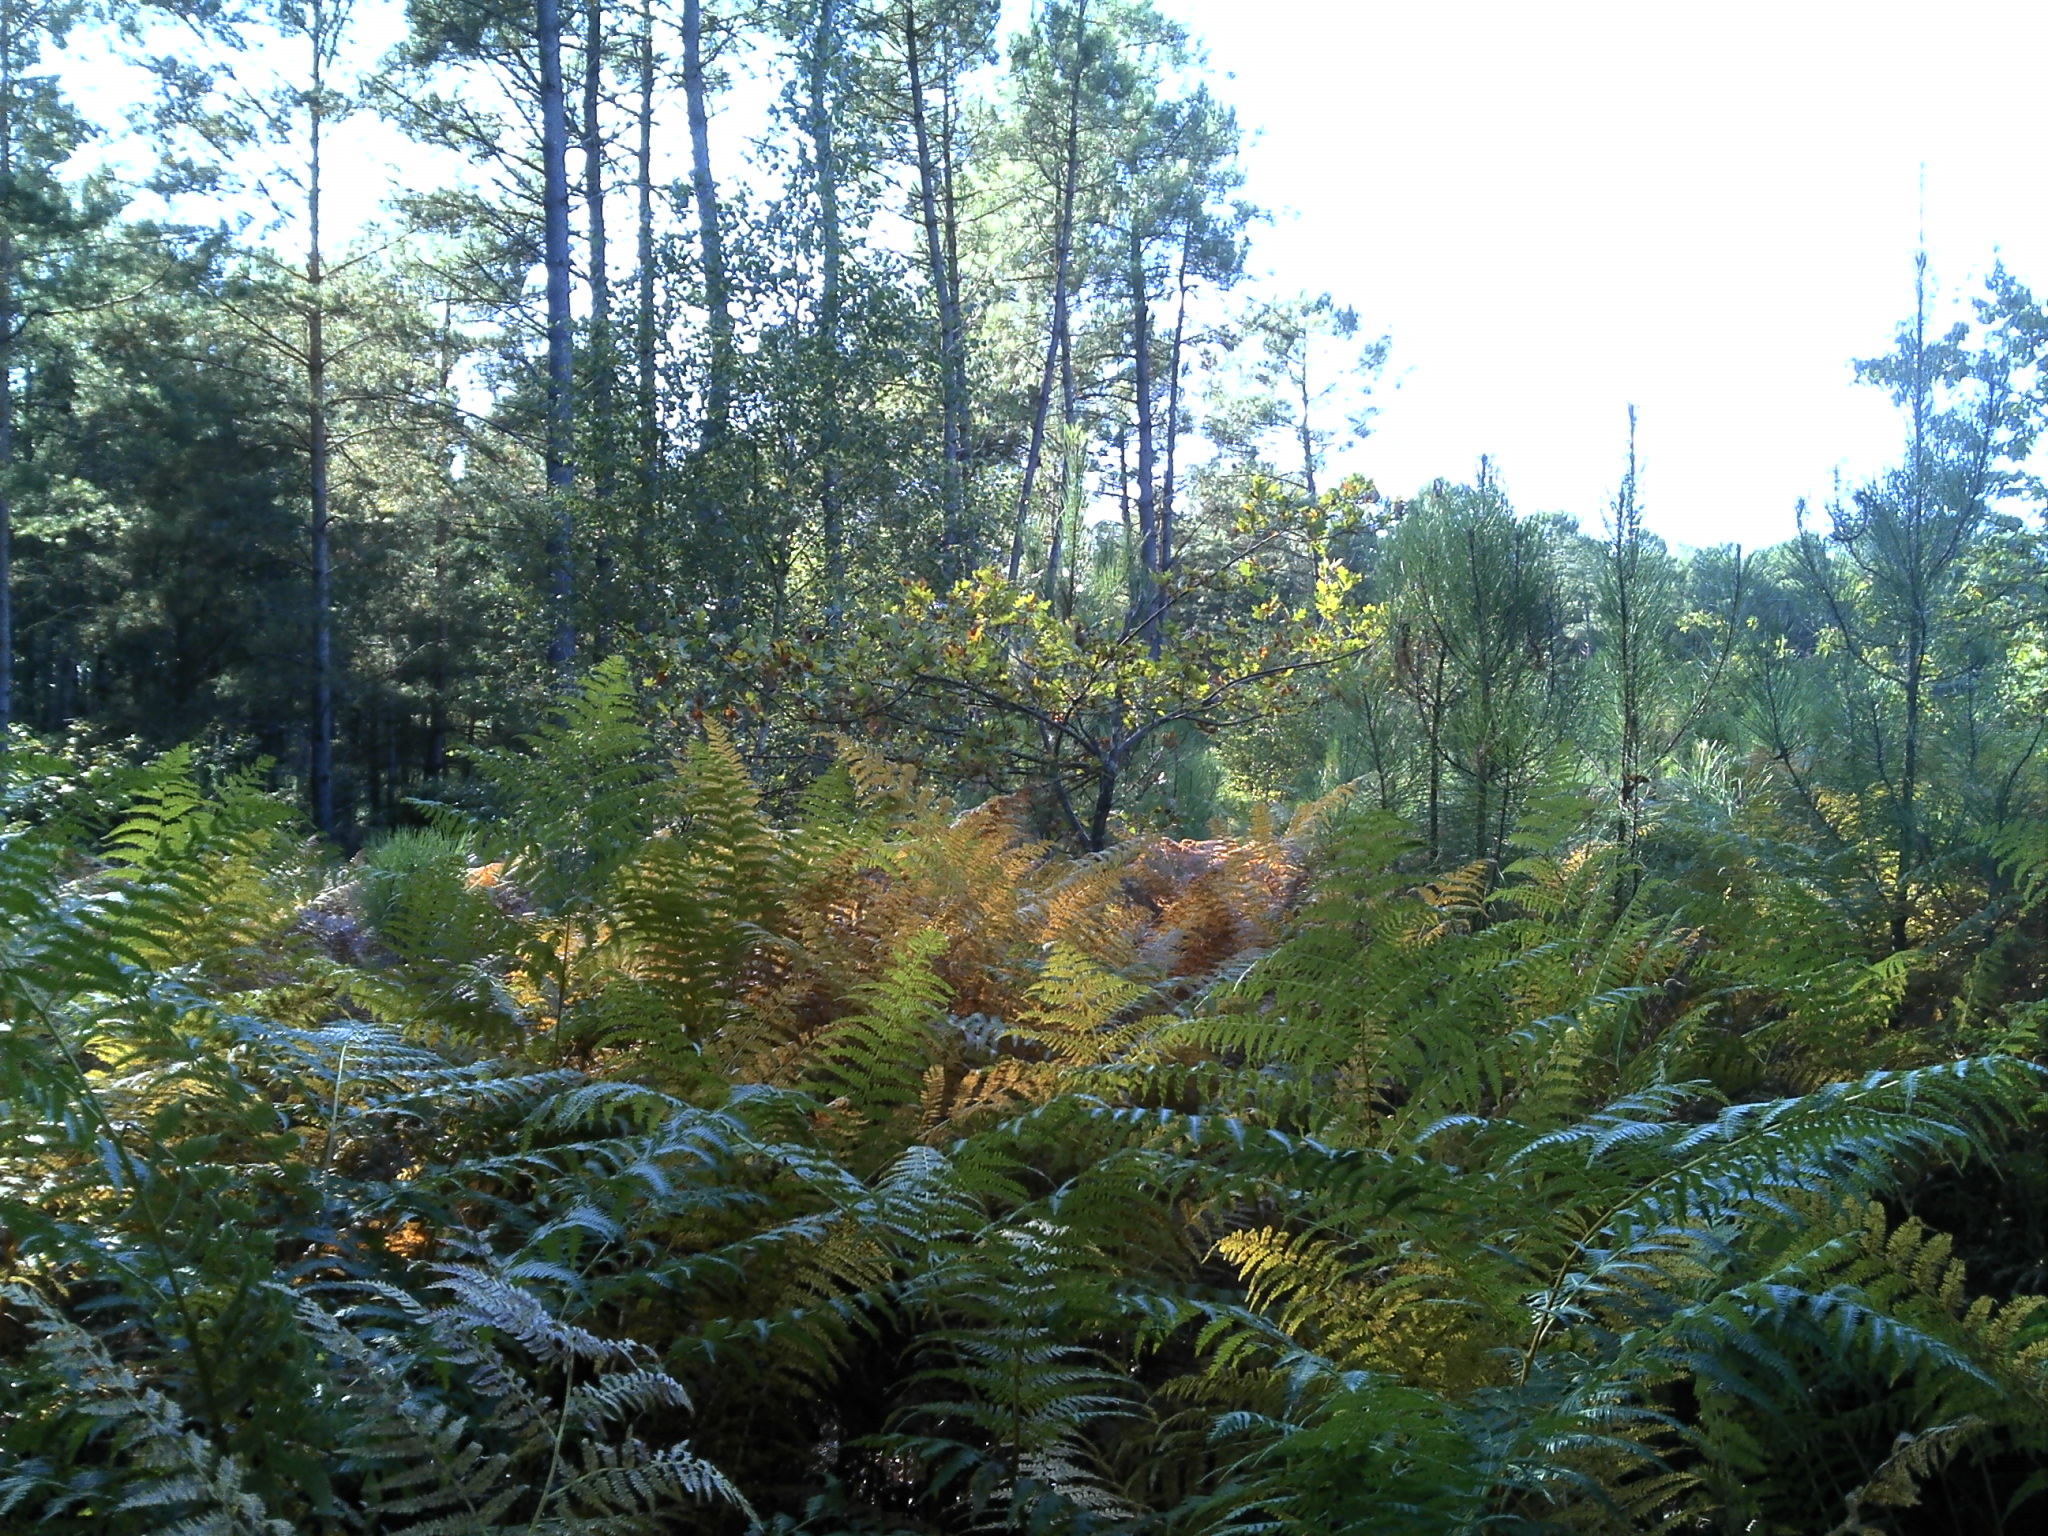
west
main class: Woodland
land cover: Pine dominated mixed woodland
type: hemiboreal forest and nemoral coniferous forest and mixed broadleaved-coniferous forest
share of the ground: > 75 %
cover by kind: coniferous forest trees 75 %, broadleaved forest trees 25 %
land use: Forestry
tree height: > 5 m
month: September
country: FR
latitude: 47.7969
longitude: 0.3235
